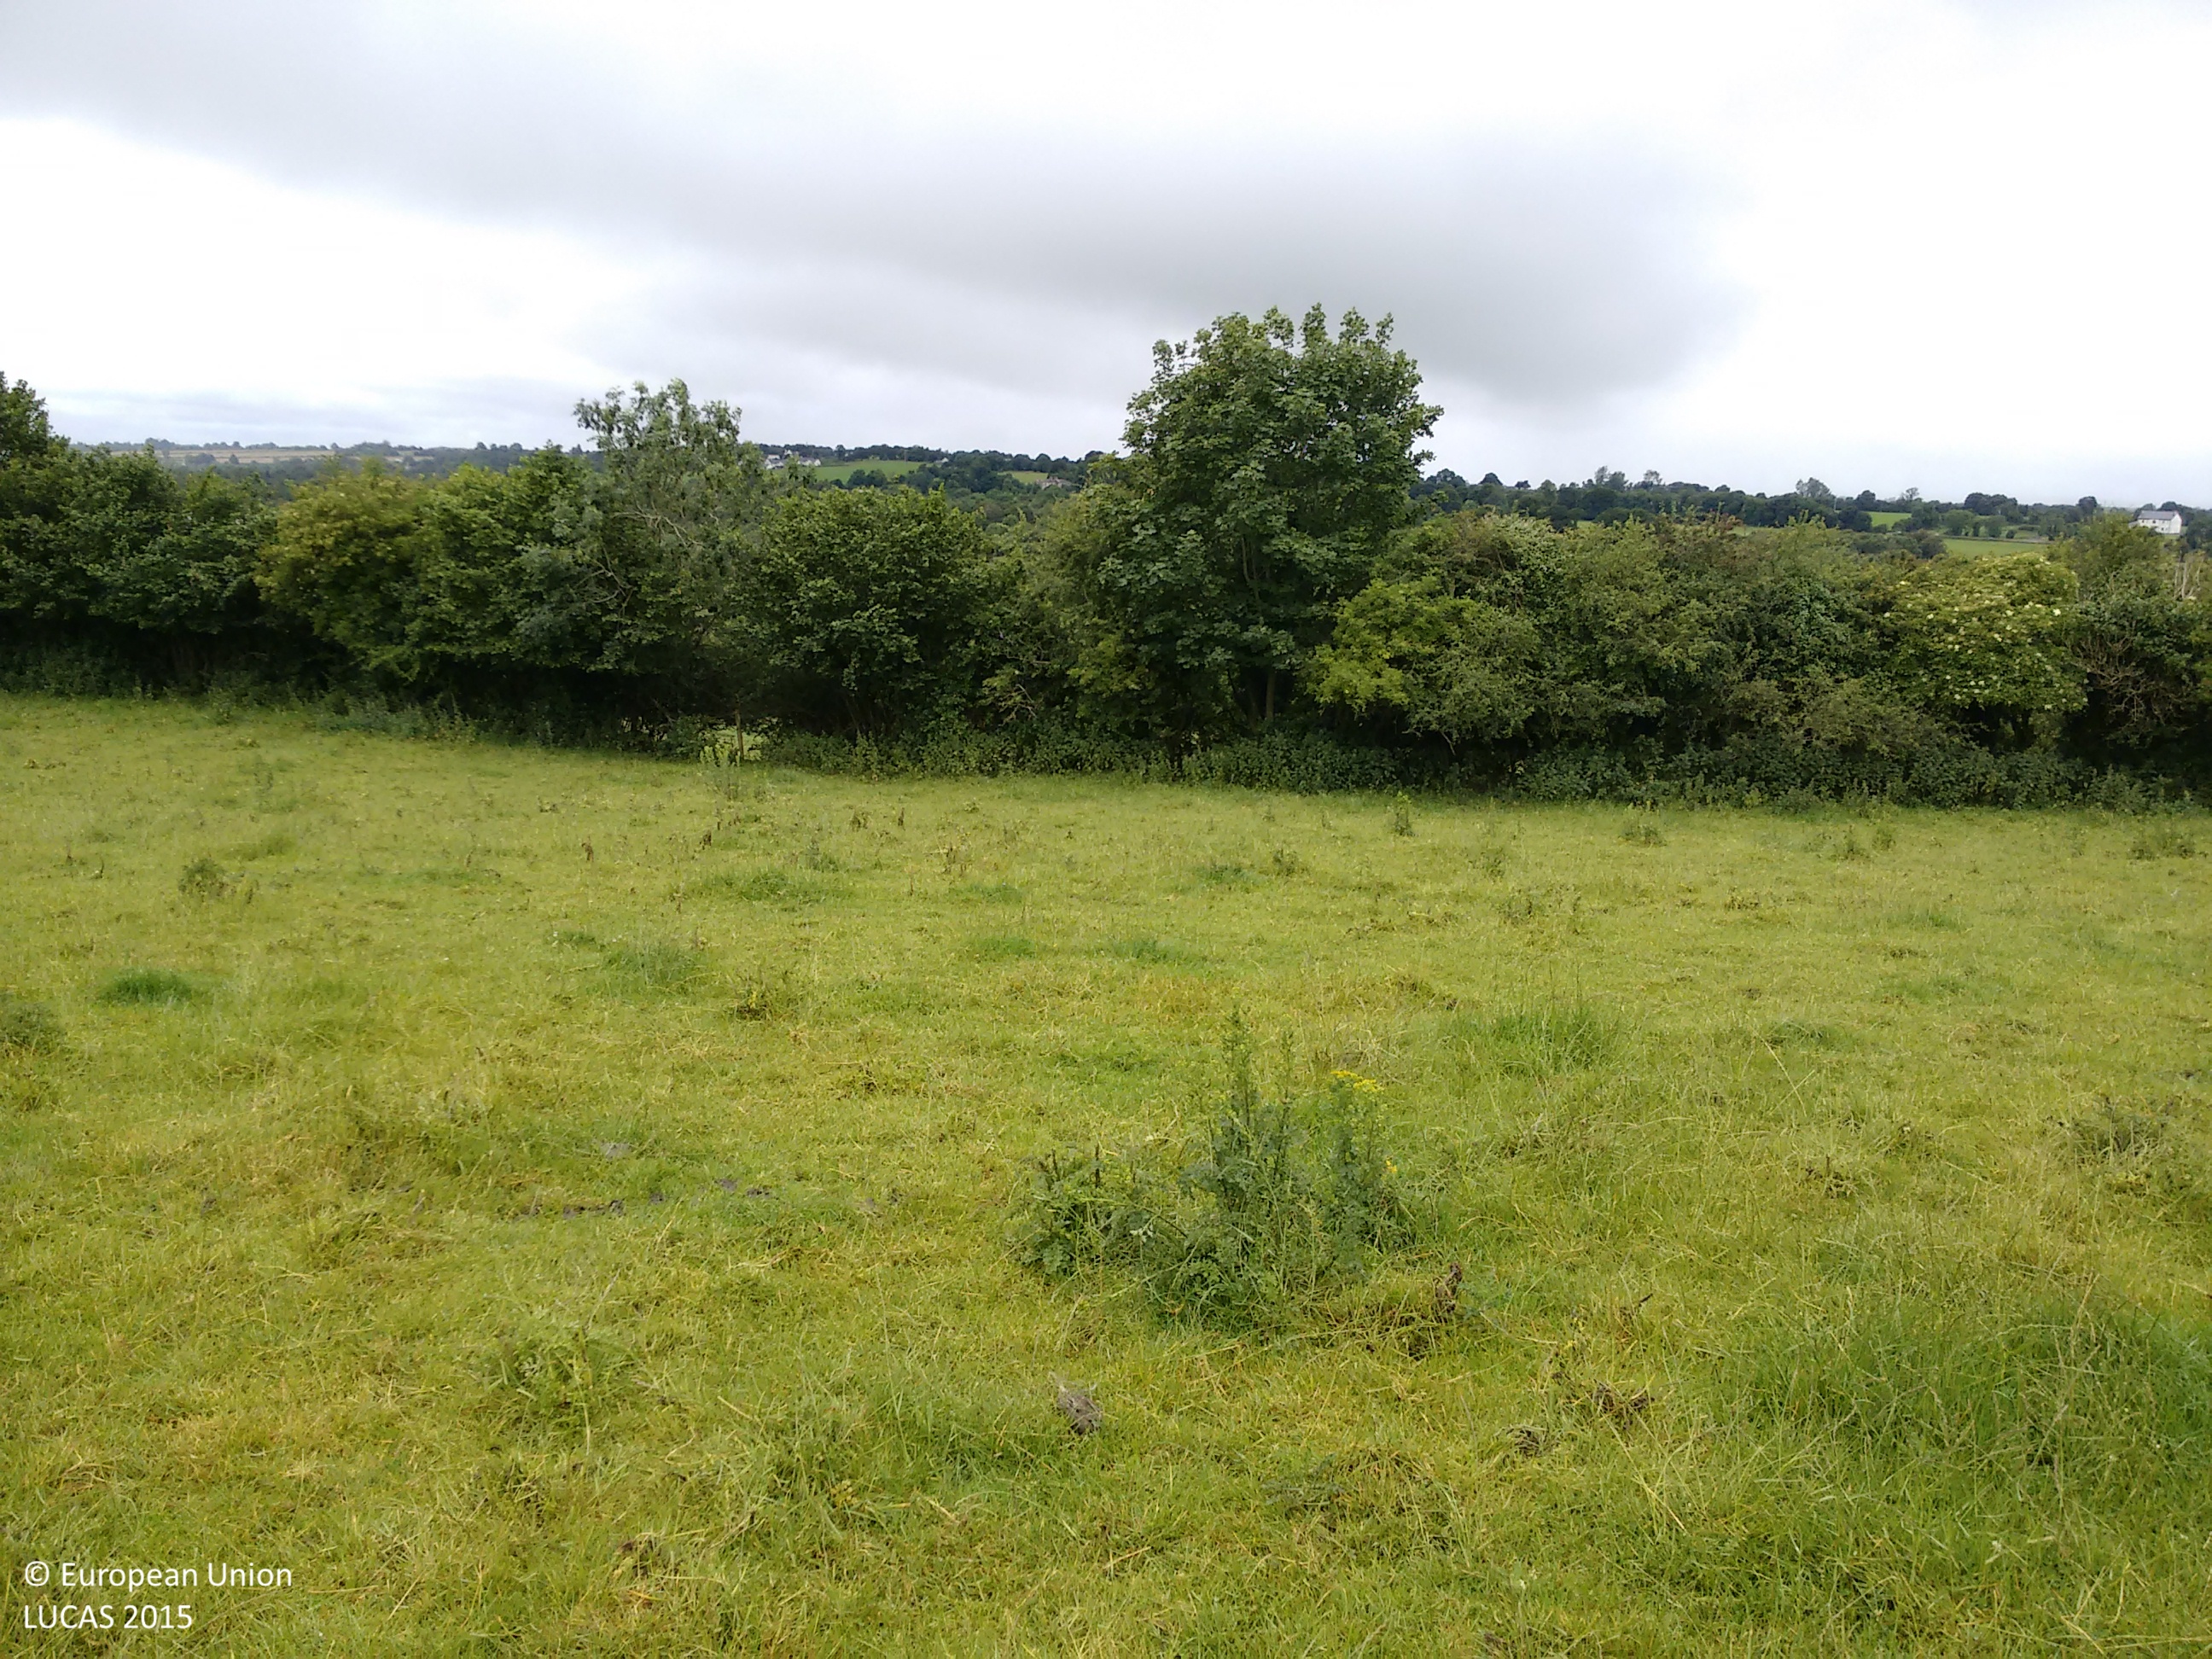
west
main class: Grassland
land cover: Grassland without tree/shrub cover
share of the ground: > 75 %
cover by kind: herbaceous plants 100 %
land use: Agriculture (excluding fallow land and kitchen gardens)
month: July
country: IE
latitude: 53.5024
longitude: -7.8233
